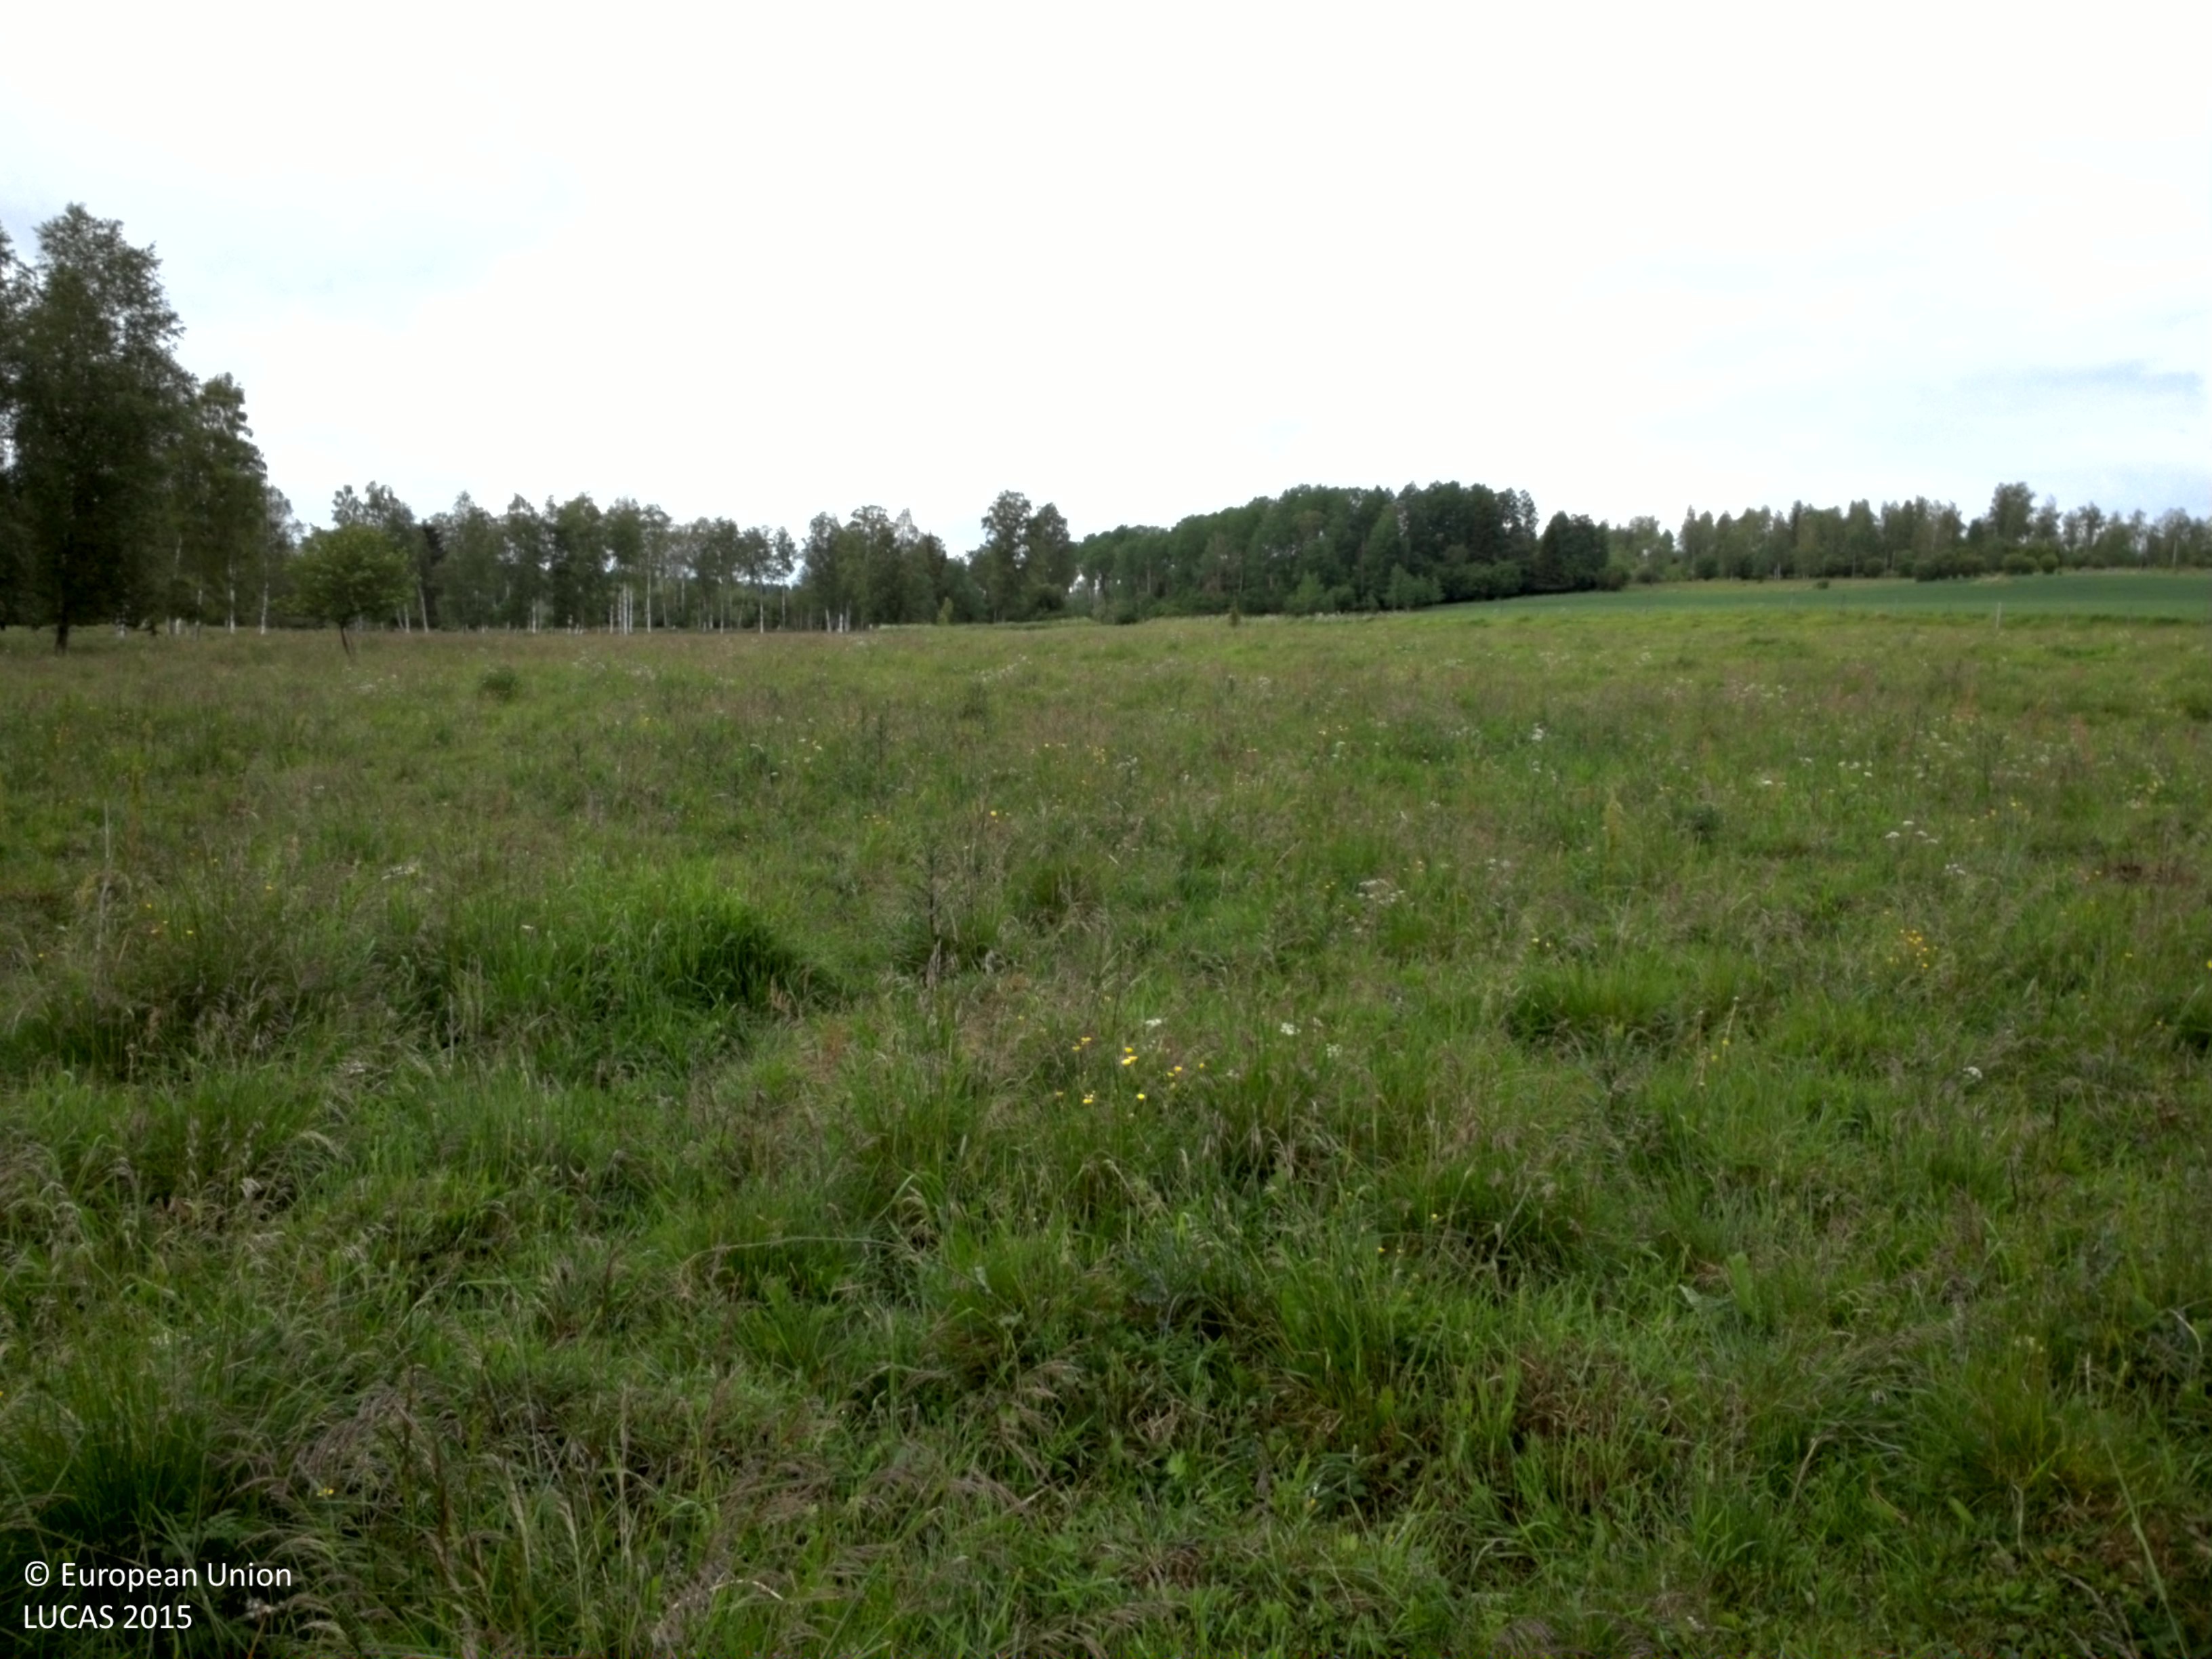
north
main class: Grassland
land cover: Grassland without tree/shrub cover
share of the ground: > 75 %
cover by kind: herbaceous plants 100 %
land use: Agriculture (excluding fallow land and kitchen gardens)
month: June
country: SE
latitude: 59.8617
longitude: 17.0096
